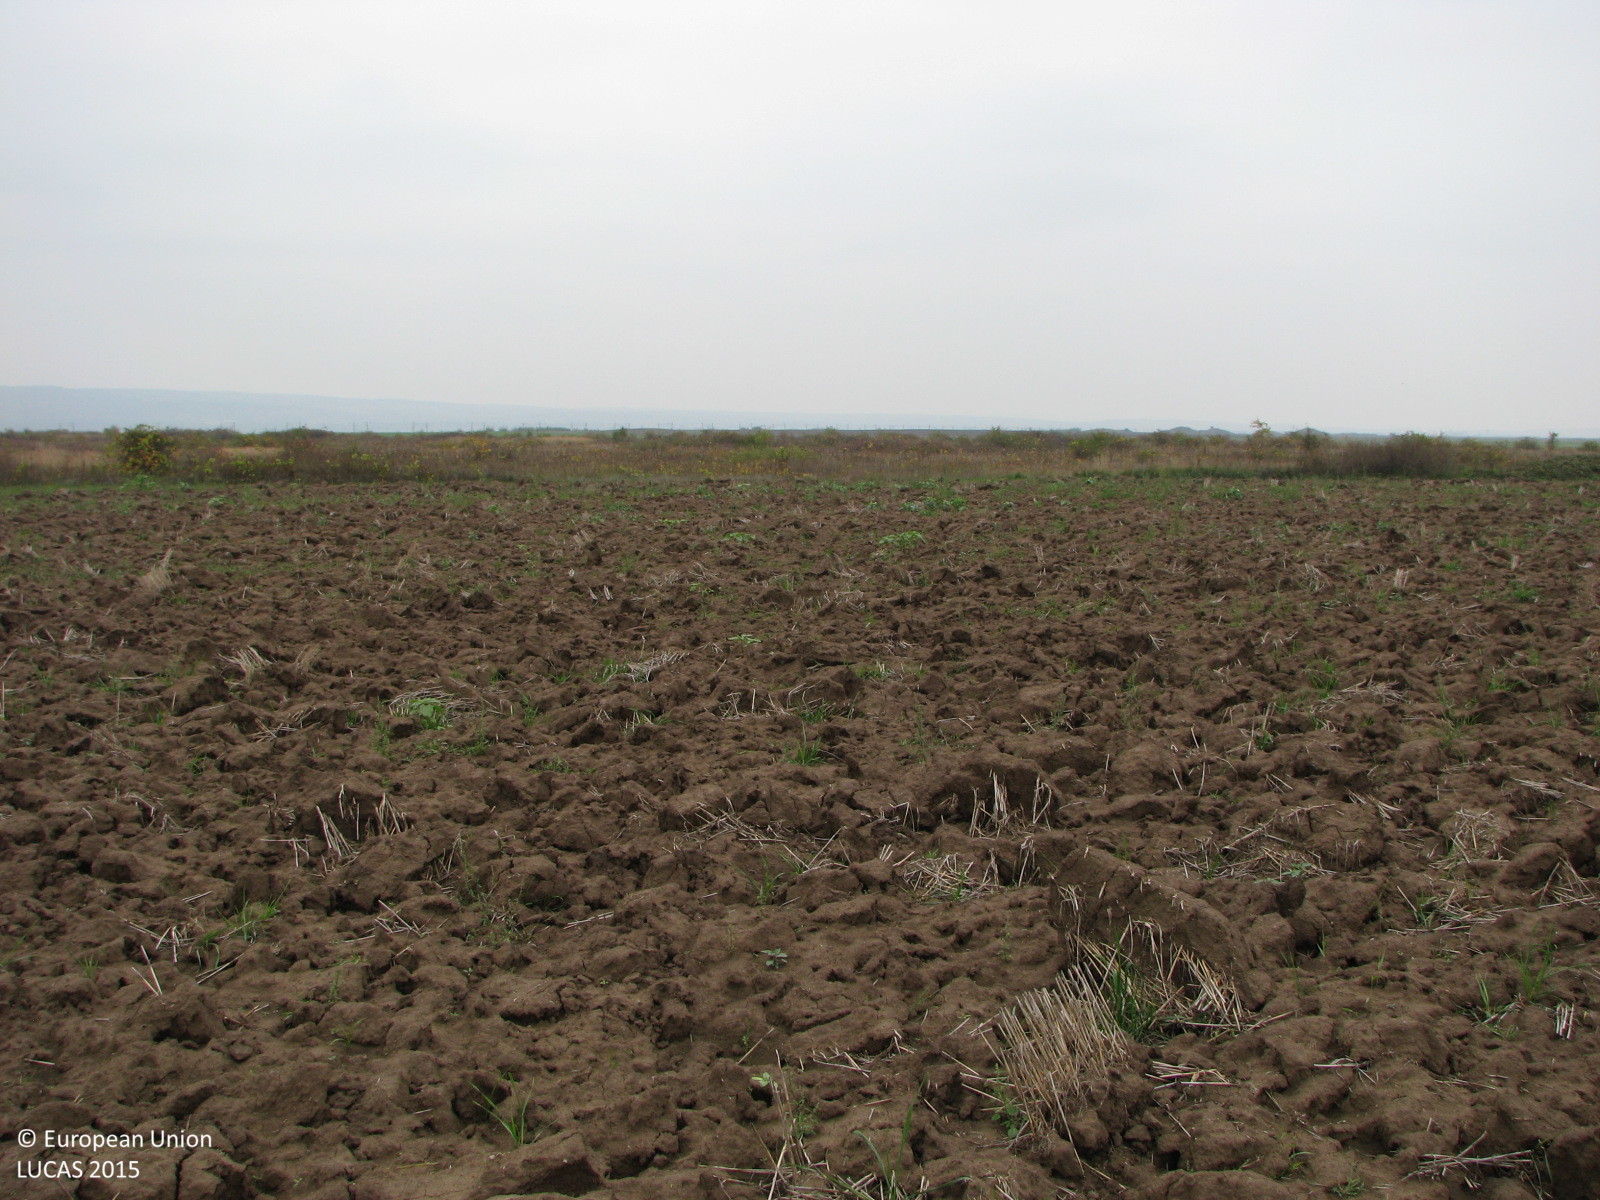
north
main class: Cropland
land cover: Common wheat
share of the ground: < 10 %
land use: Agriculture (excluding fallow land and kitchen gardens)
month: October
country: BG
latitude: 42.5896
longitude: 26.7579
